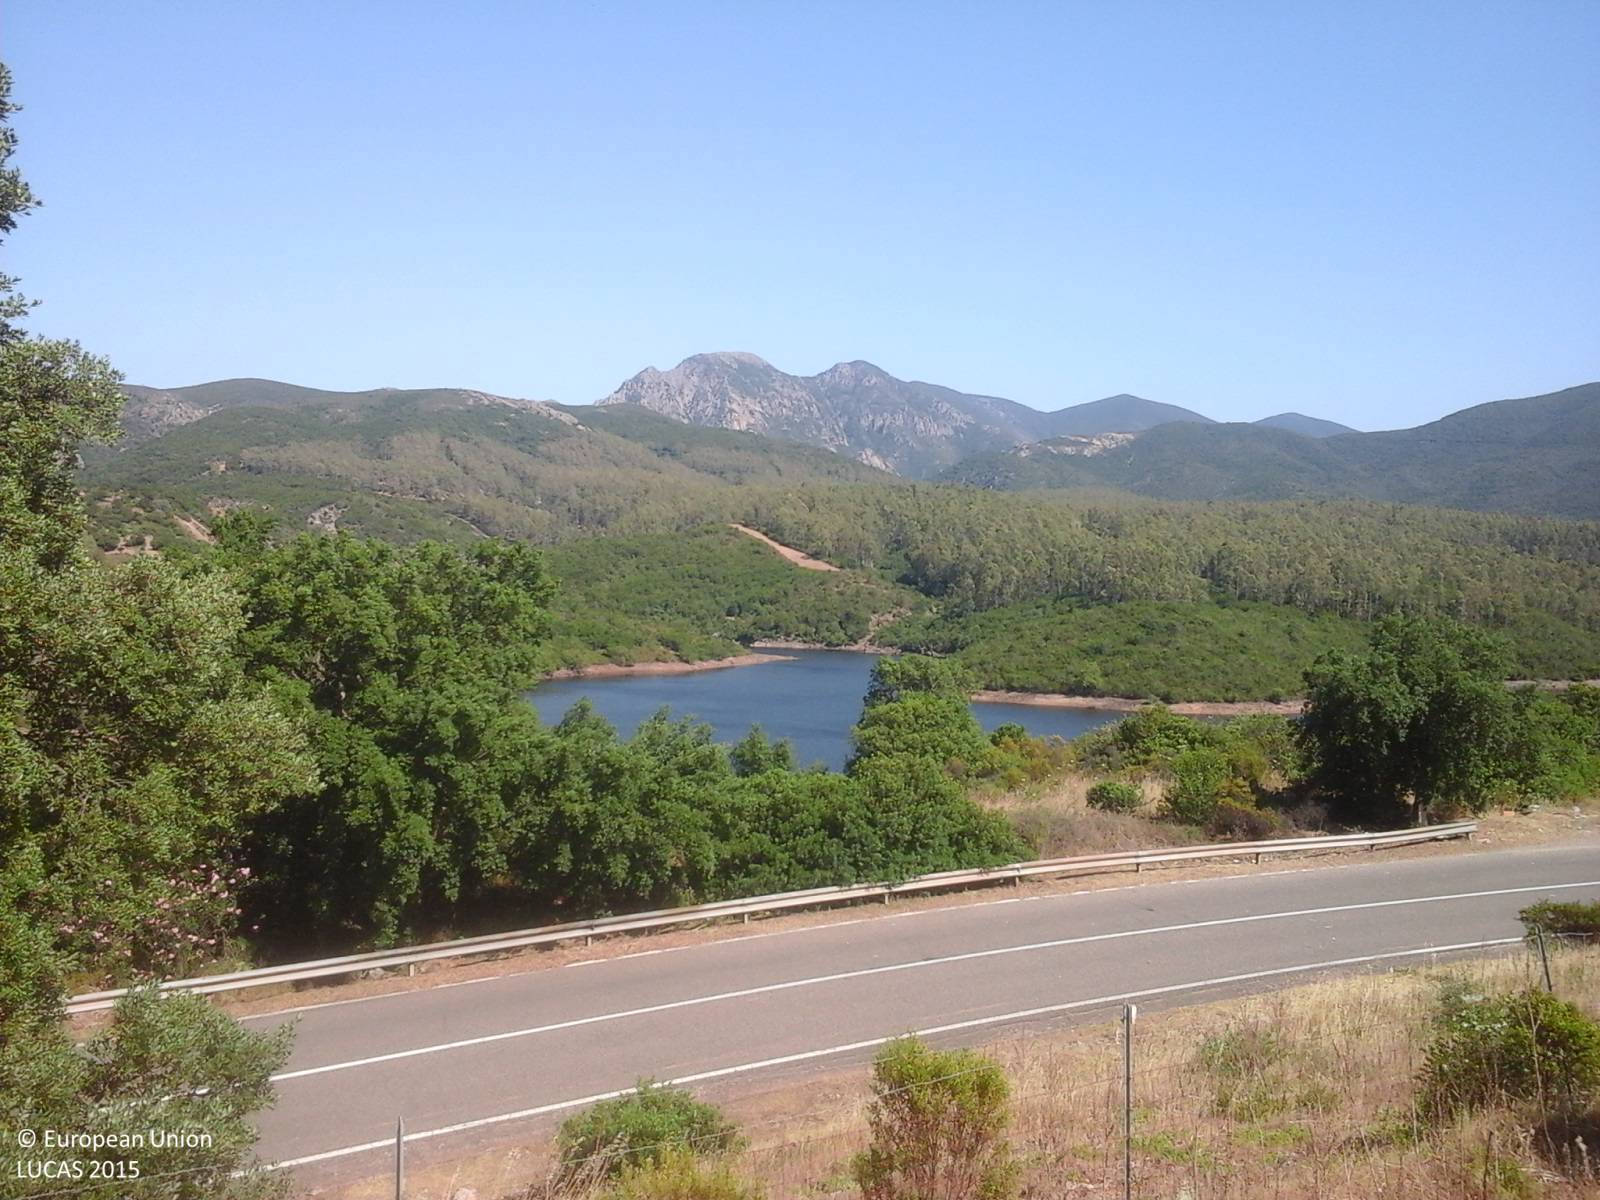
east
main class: Shrubland
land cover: Shrubland with sparse tree cover
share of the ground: > 75 %
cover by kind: shrubs 95 %, broadleaved forest trees 5 %
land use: Semi-natural and natural areas not in use
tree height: > 5 m
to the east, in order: Shrubland with sparse tree cover; Fences; Shrubland with sparse tree cover; Grass margins; Paved roads, cycling and walking lanes; Grass margins; Shrubland with sparse tree cover; Tracks; Inland fresh water bodies
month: June
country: IT
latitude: 39.1909
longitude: 8.7688
